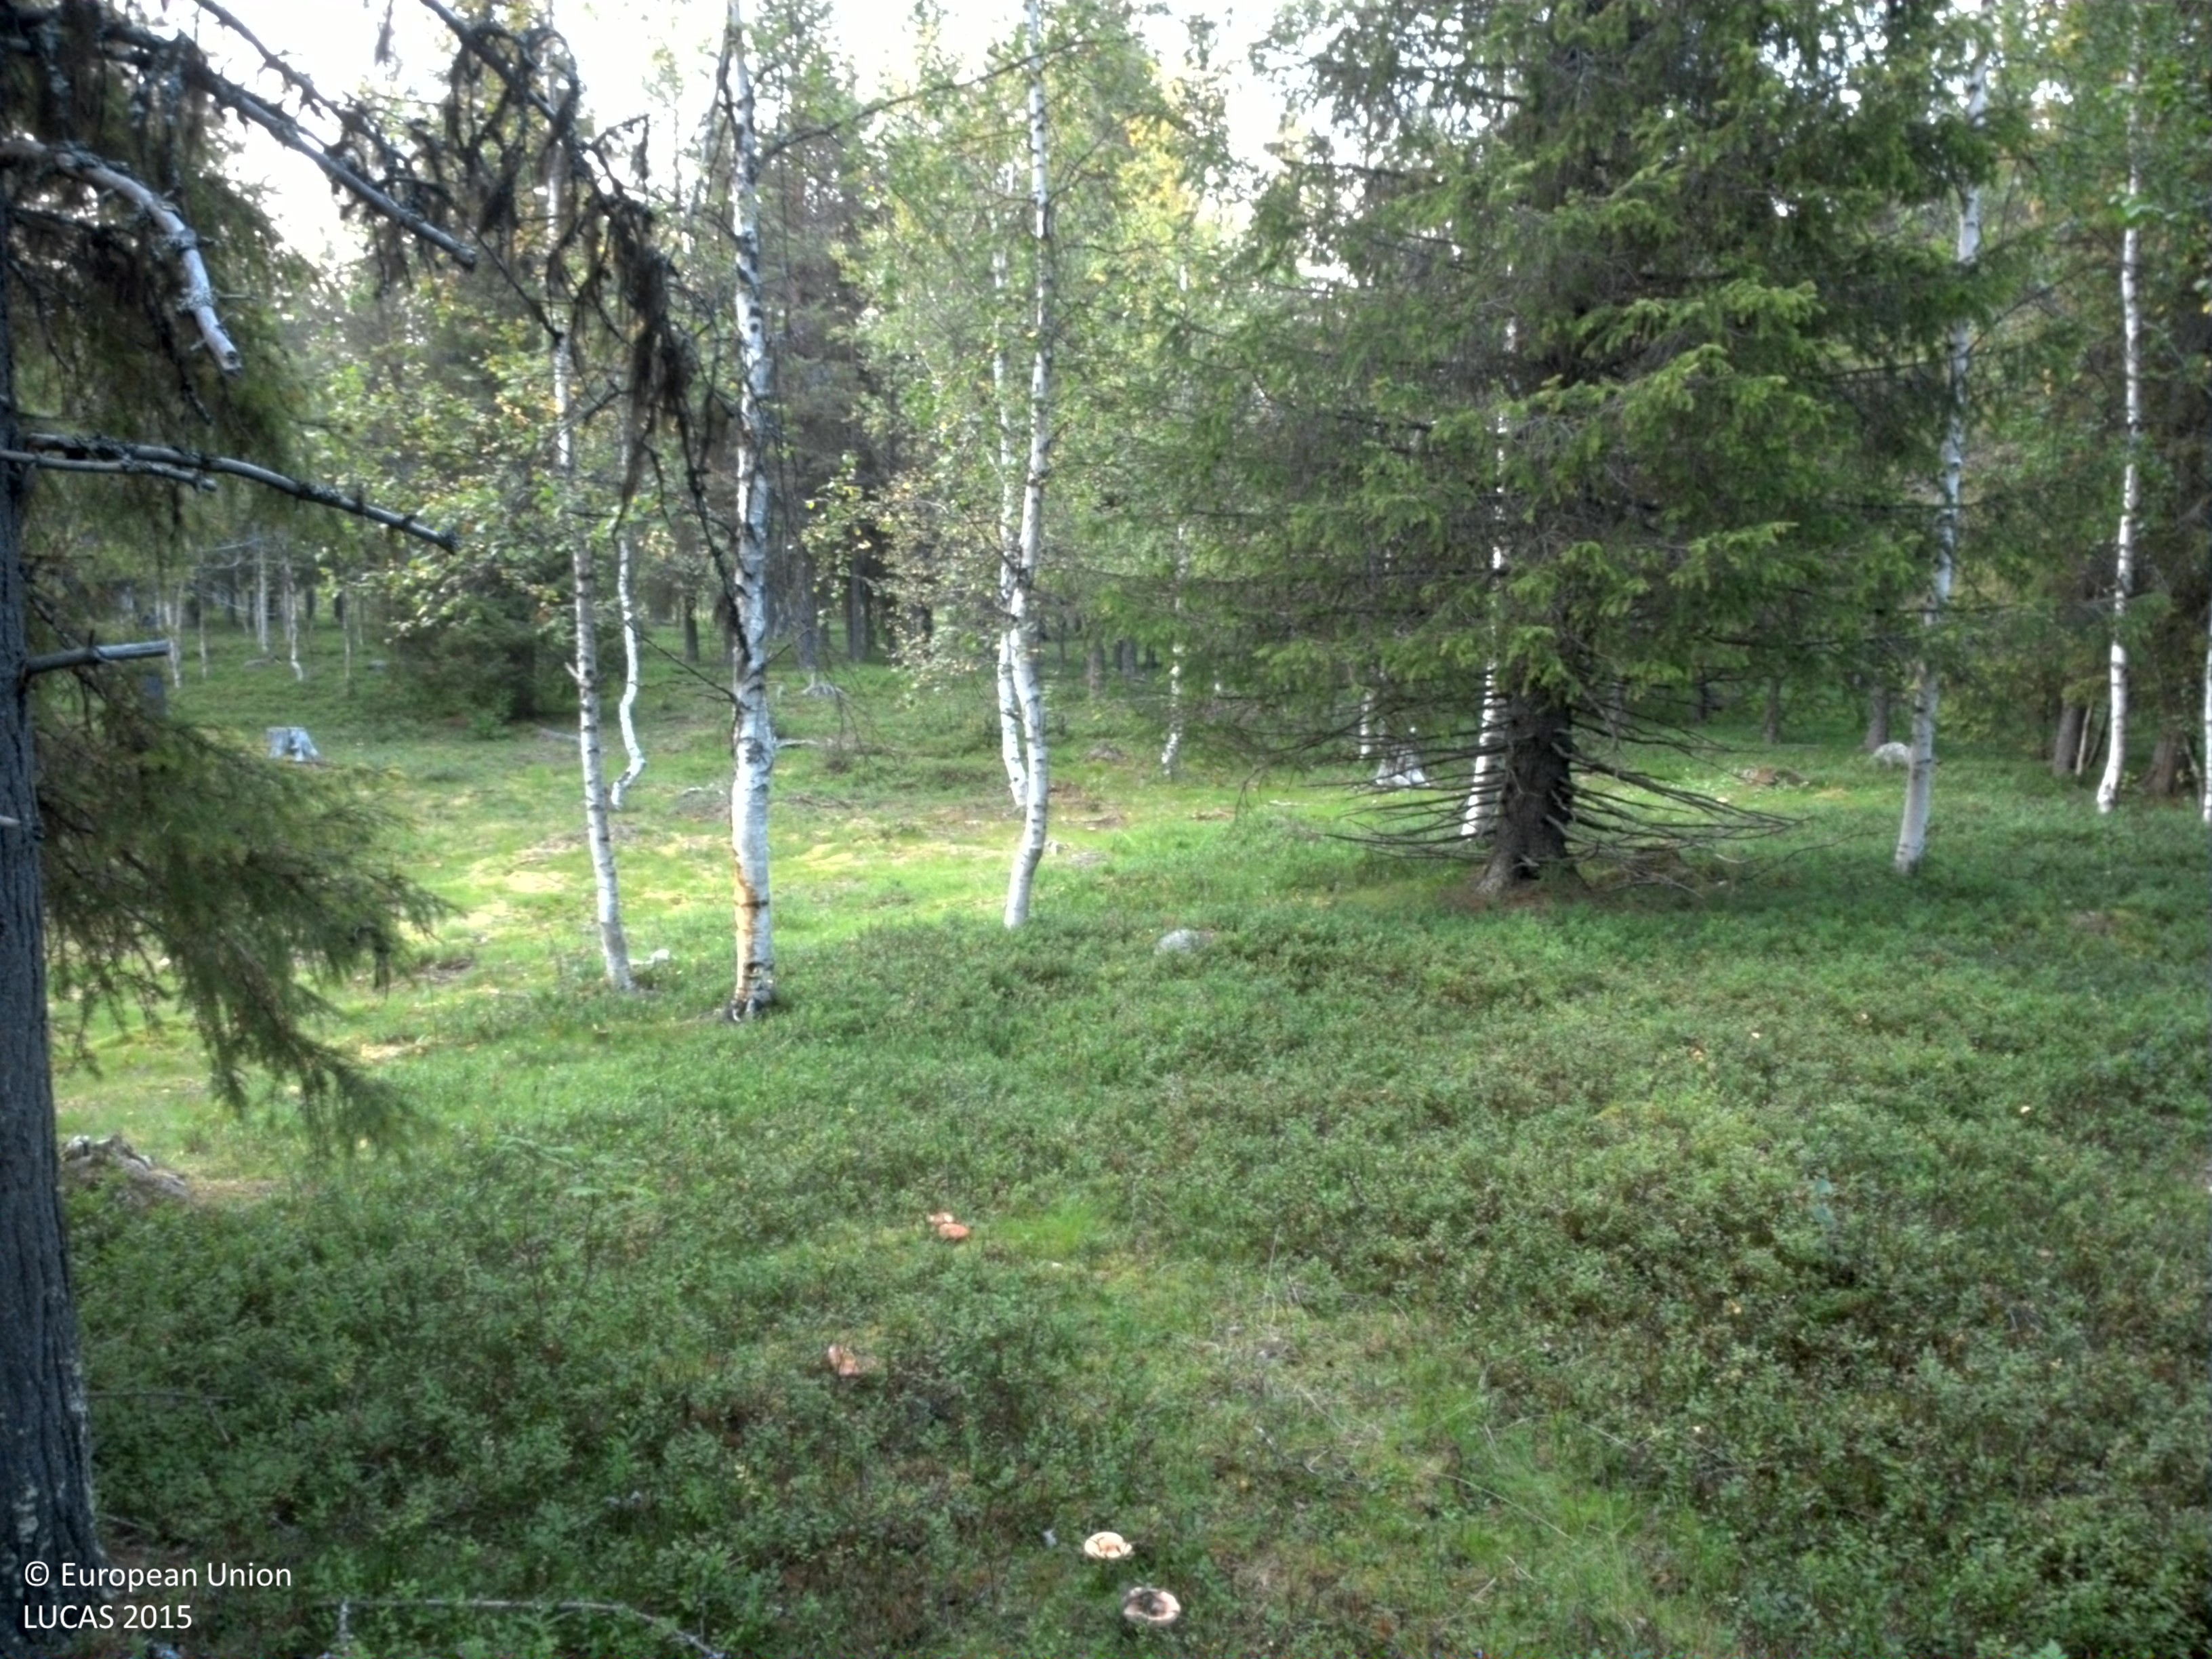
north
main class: Woodland
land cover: Pine dominated coniferous woodland
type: boreal forest
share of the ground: 25 - 50 %
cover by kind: shrubs 55 %, coniferous forest trees 30 %, broadleaved forest trees 5 %, herbaceous plants 5 %, lichens and mosses 5 %
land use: Forestry
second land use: Other primary production
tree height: > 5 m
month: August
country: SE
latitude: 66.6553
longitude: 20.6065
